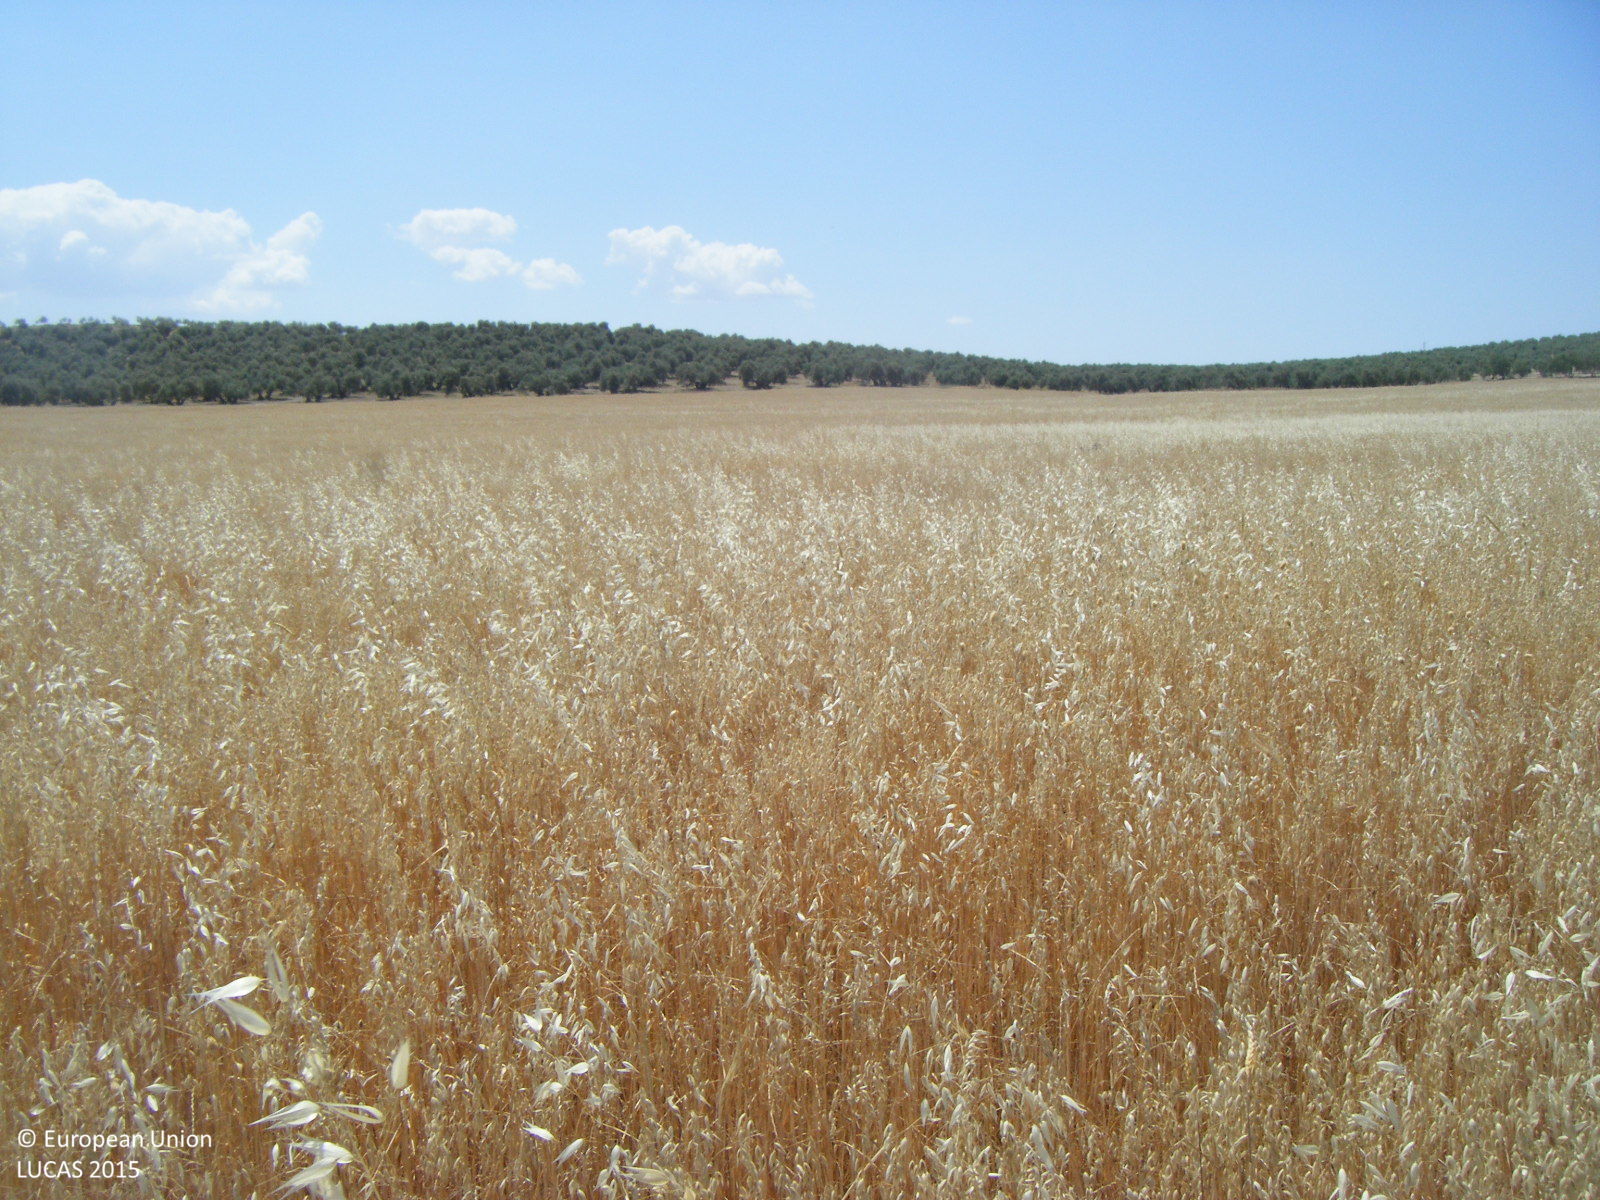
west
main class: Cropland
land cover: Oats
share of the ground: > 75 %
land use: Agriculture (excluding fallow land and kitchen gardens)
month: May
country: ES
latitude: 37.2000
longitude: -4.4993
